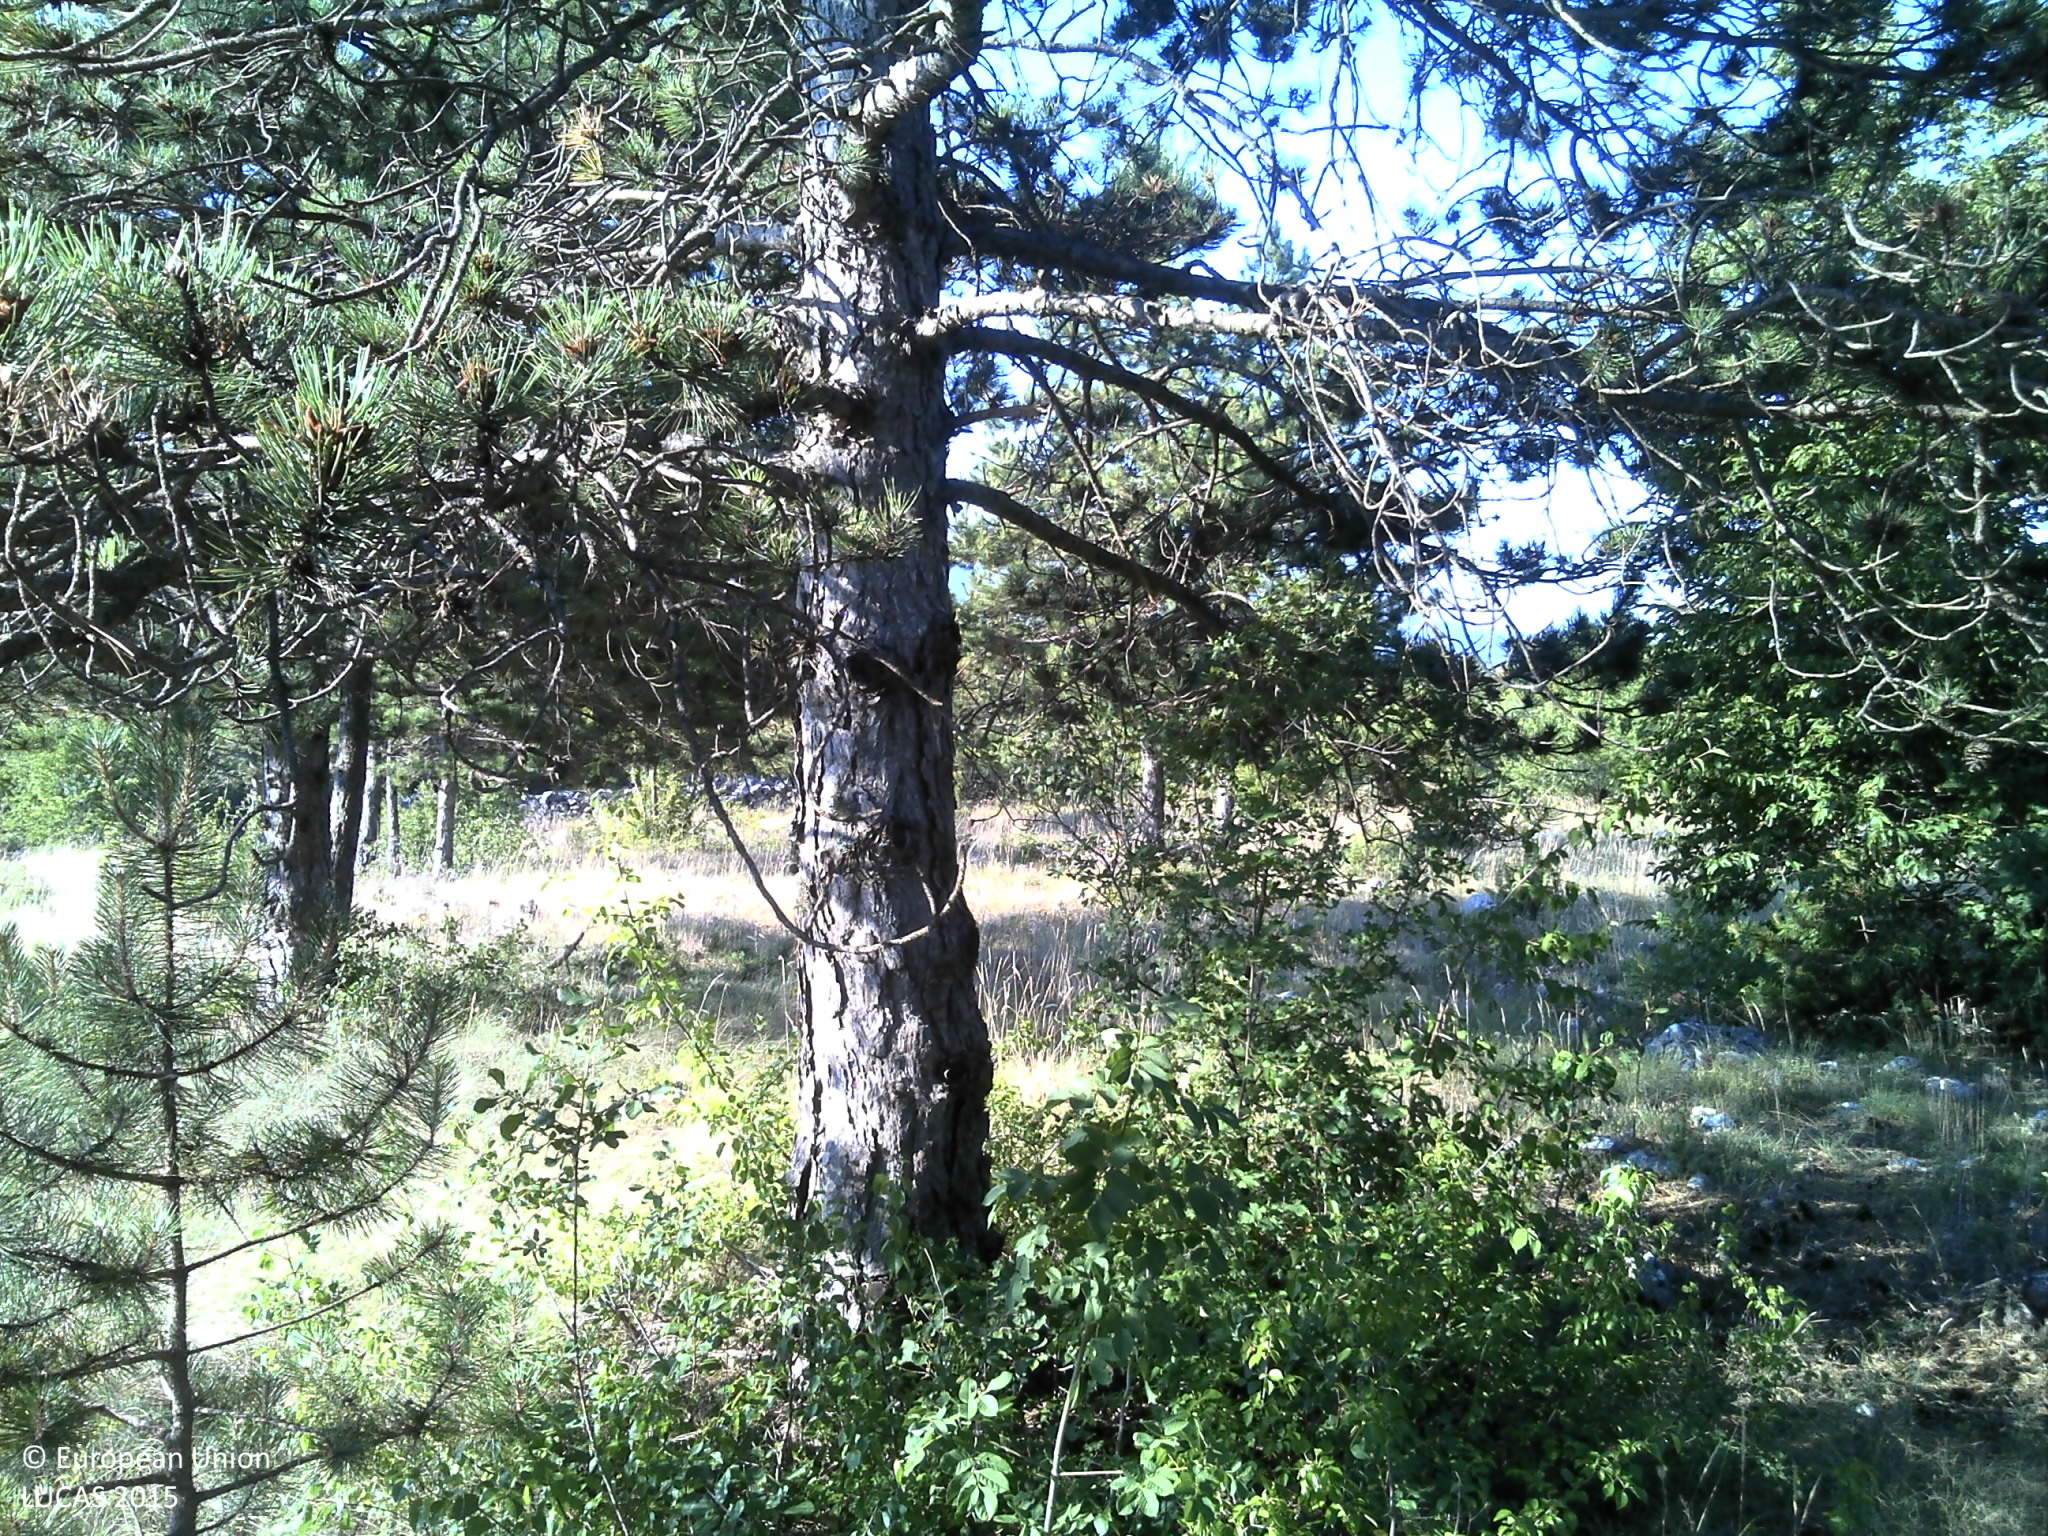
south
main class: Woodland
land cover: Pine dominated coniferous woodland
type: coniferous forest of the mediterranean region
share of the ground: 50 - 75 %
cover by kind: coniferous forest trees 60 %, herbaceous plants 25 %, shrubs 5 %, consolidated bare surface 5 %, unconsolidated bare surface 5 %
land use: Semi-natural and natural areas not in use
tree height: > 5 m
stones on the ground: < 10 %
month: July
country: HR
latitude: 43.4983
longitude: 17.0039
